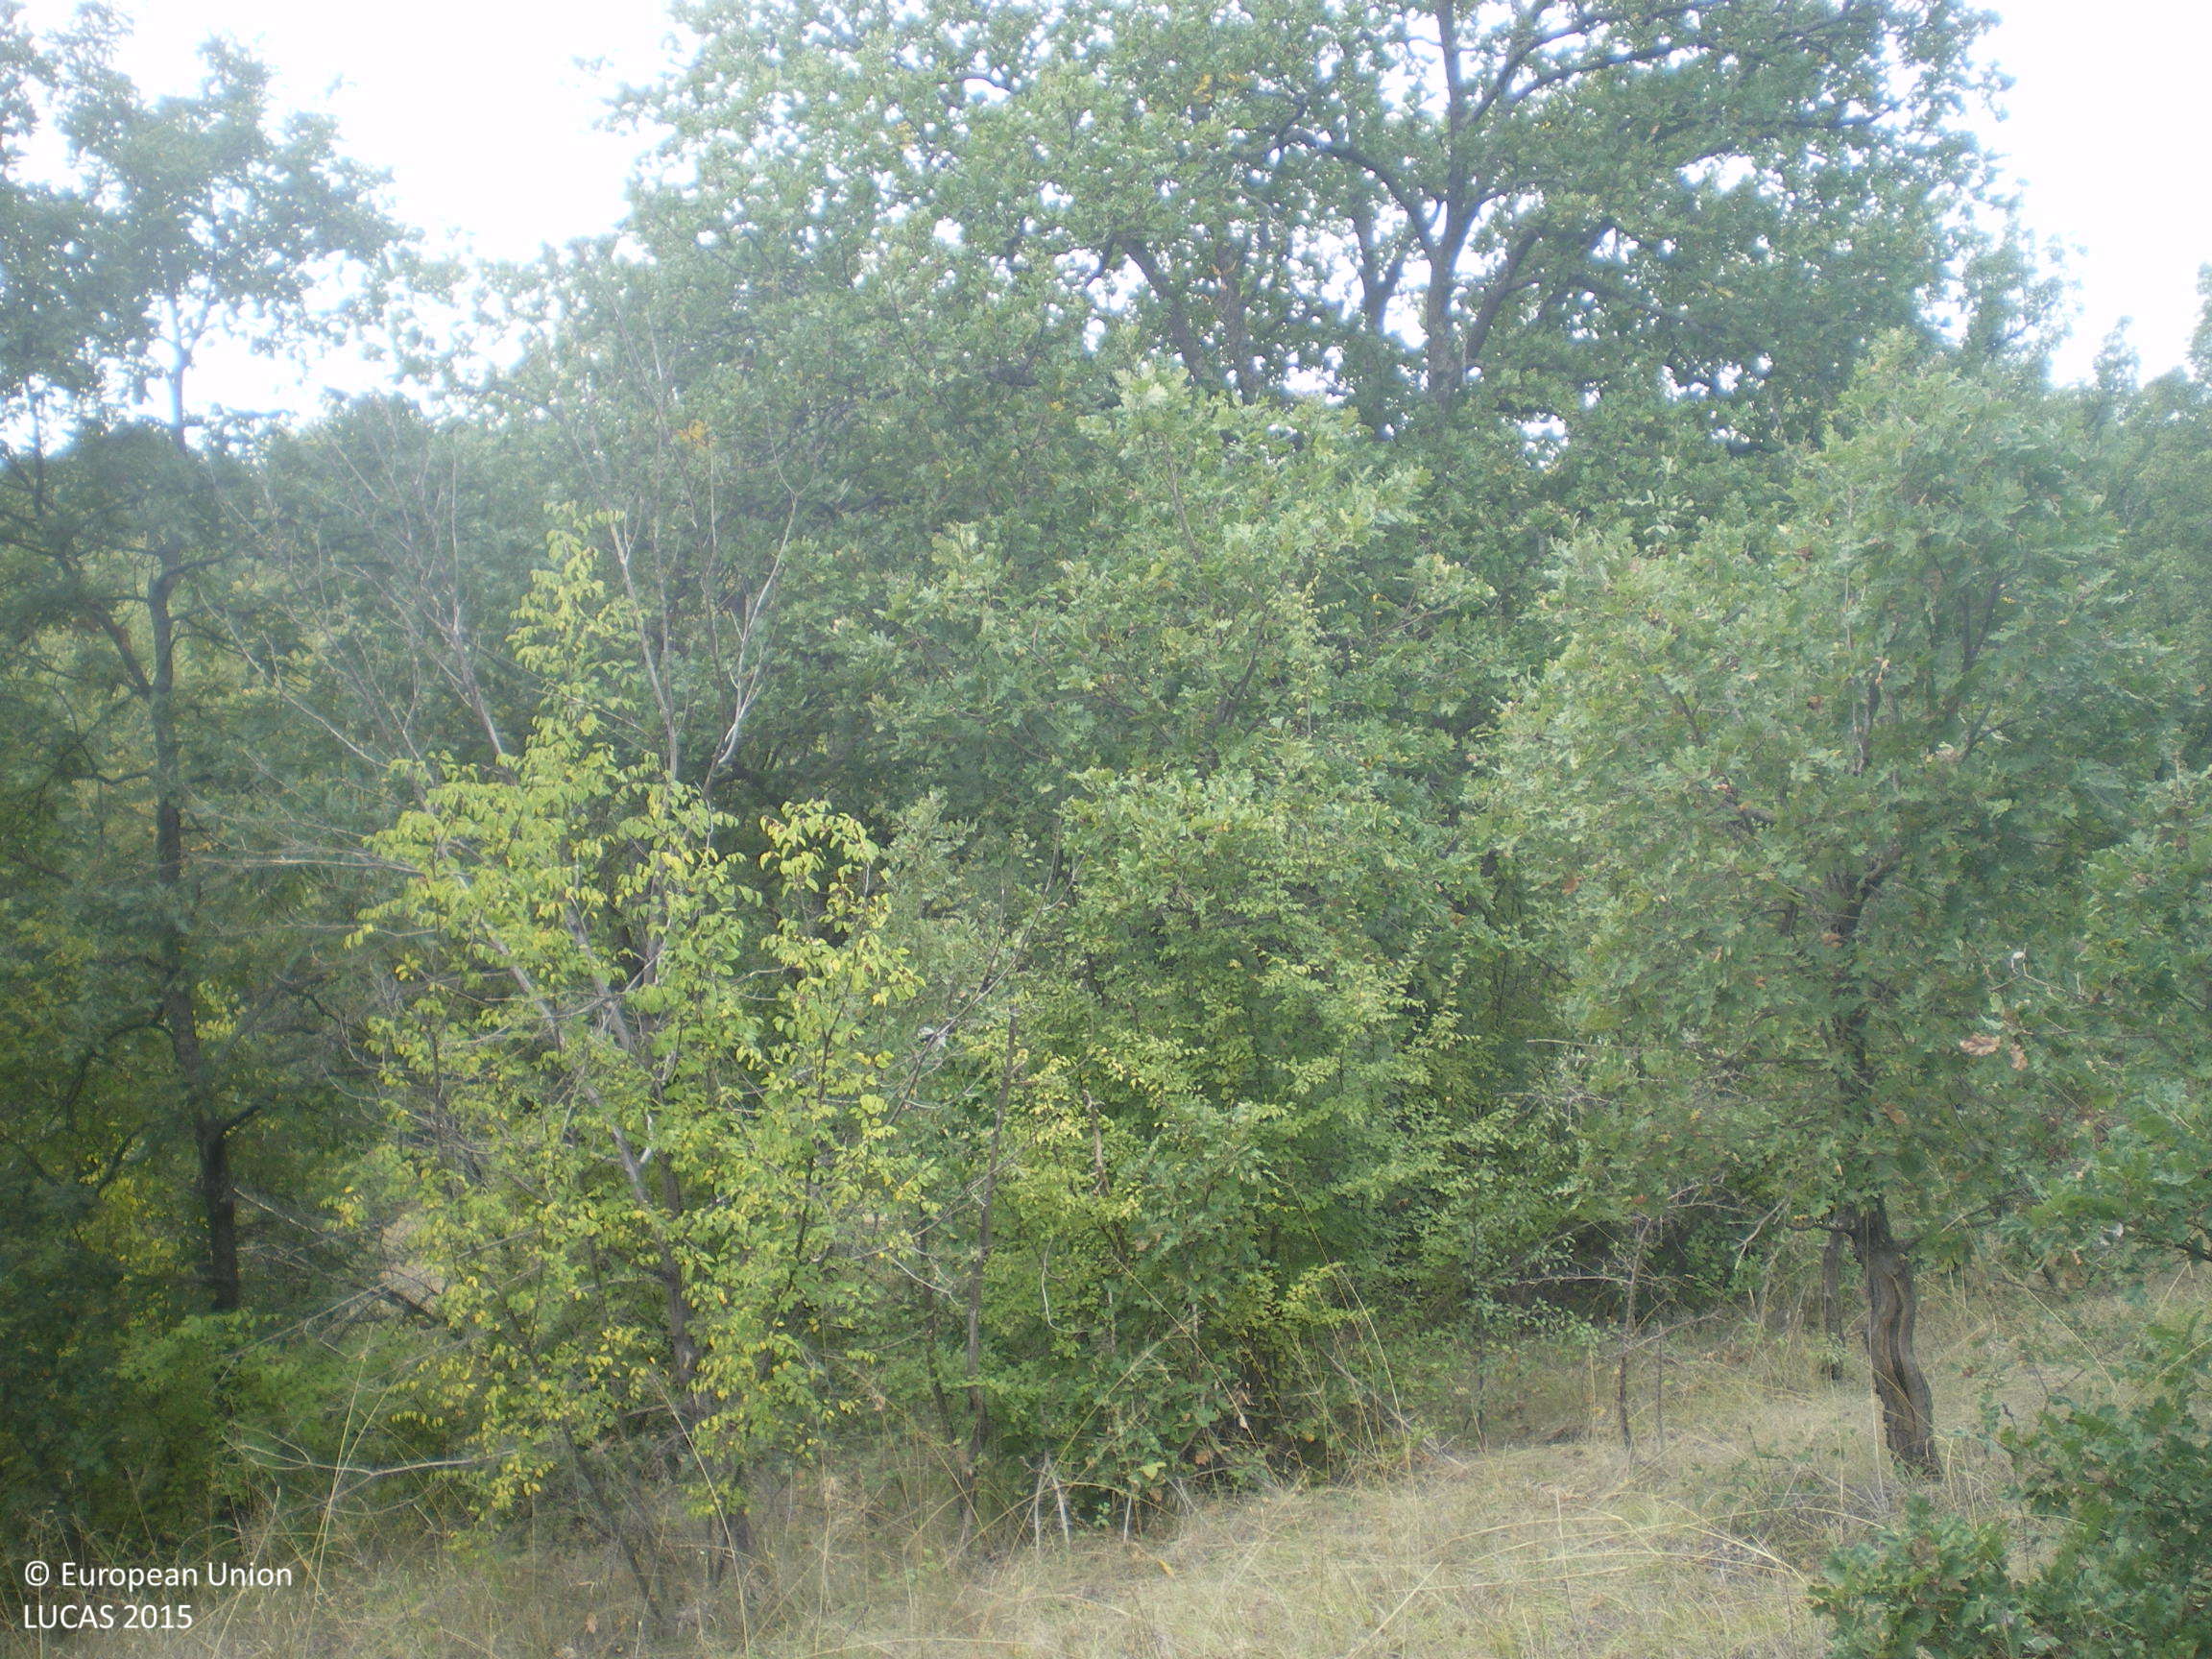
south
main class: Woodland
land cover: Broadleaved woodland
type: mesophytic deciduous forest
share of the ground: > 75 %
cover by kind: broadleaved forest trees 75 %, herbaceous plants 15 %, shrubs 10 %
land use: Forestry
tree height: > 5 m
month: October
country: BG
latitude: 41.9631
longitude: 26.2106
